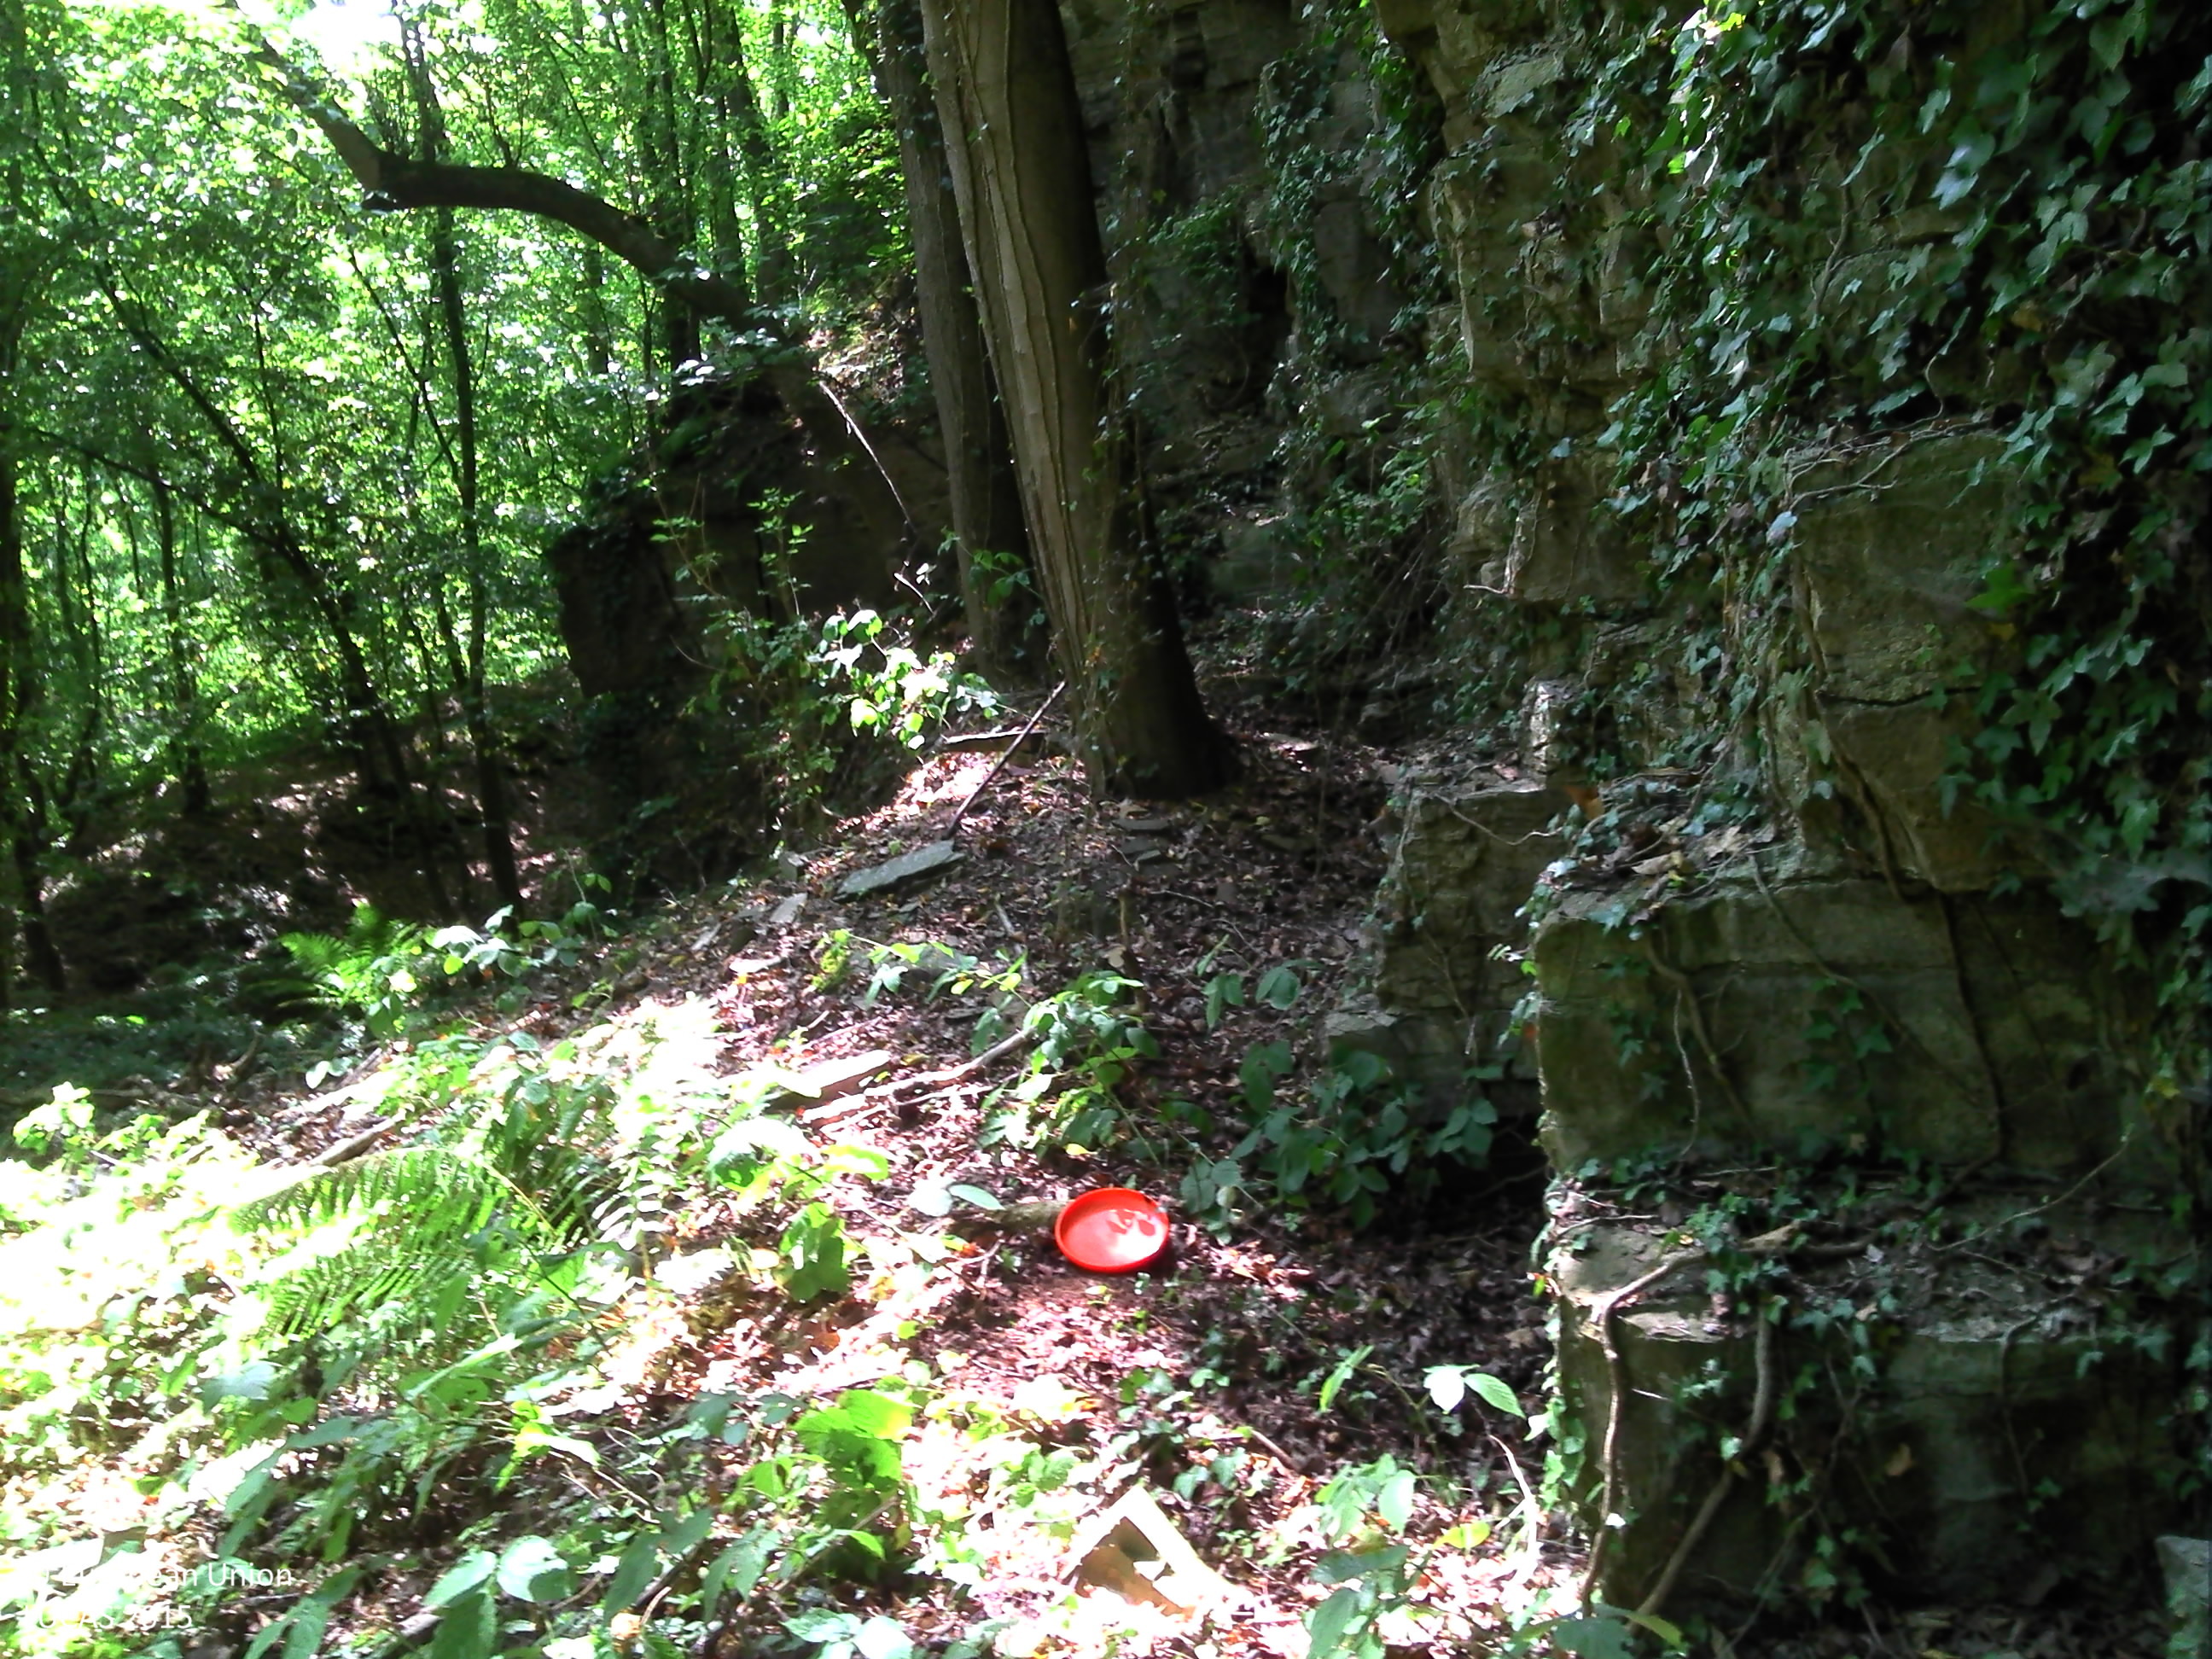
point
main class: Woodland
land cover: Broadleaved woodland
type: mesophytic deciduous forest
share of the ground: > 75 %
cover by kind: broadleaved forest trees 90 %, herbaceous plants 10 %
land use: Forestry
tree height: > 5 m
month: July
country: BE
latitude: 50.5711
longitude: 5.6921
